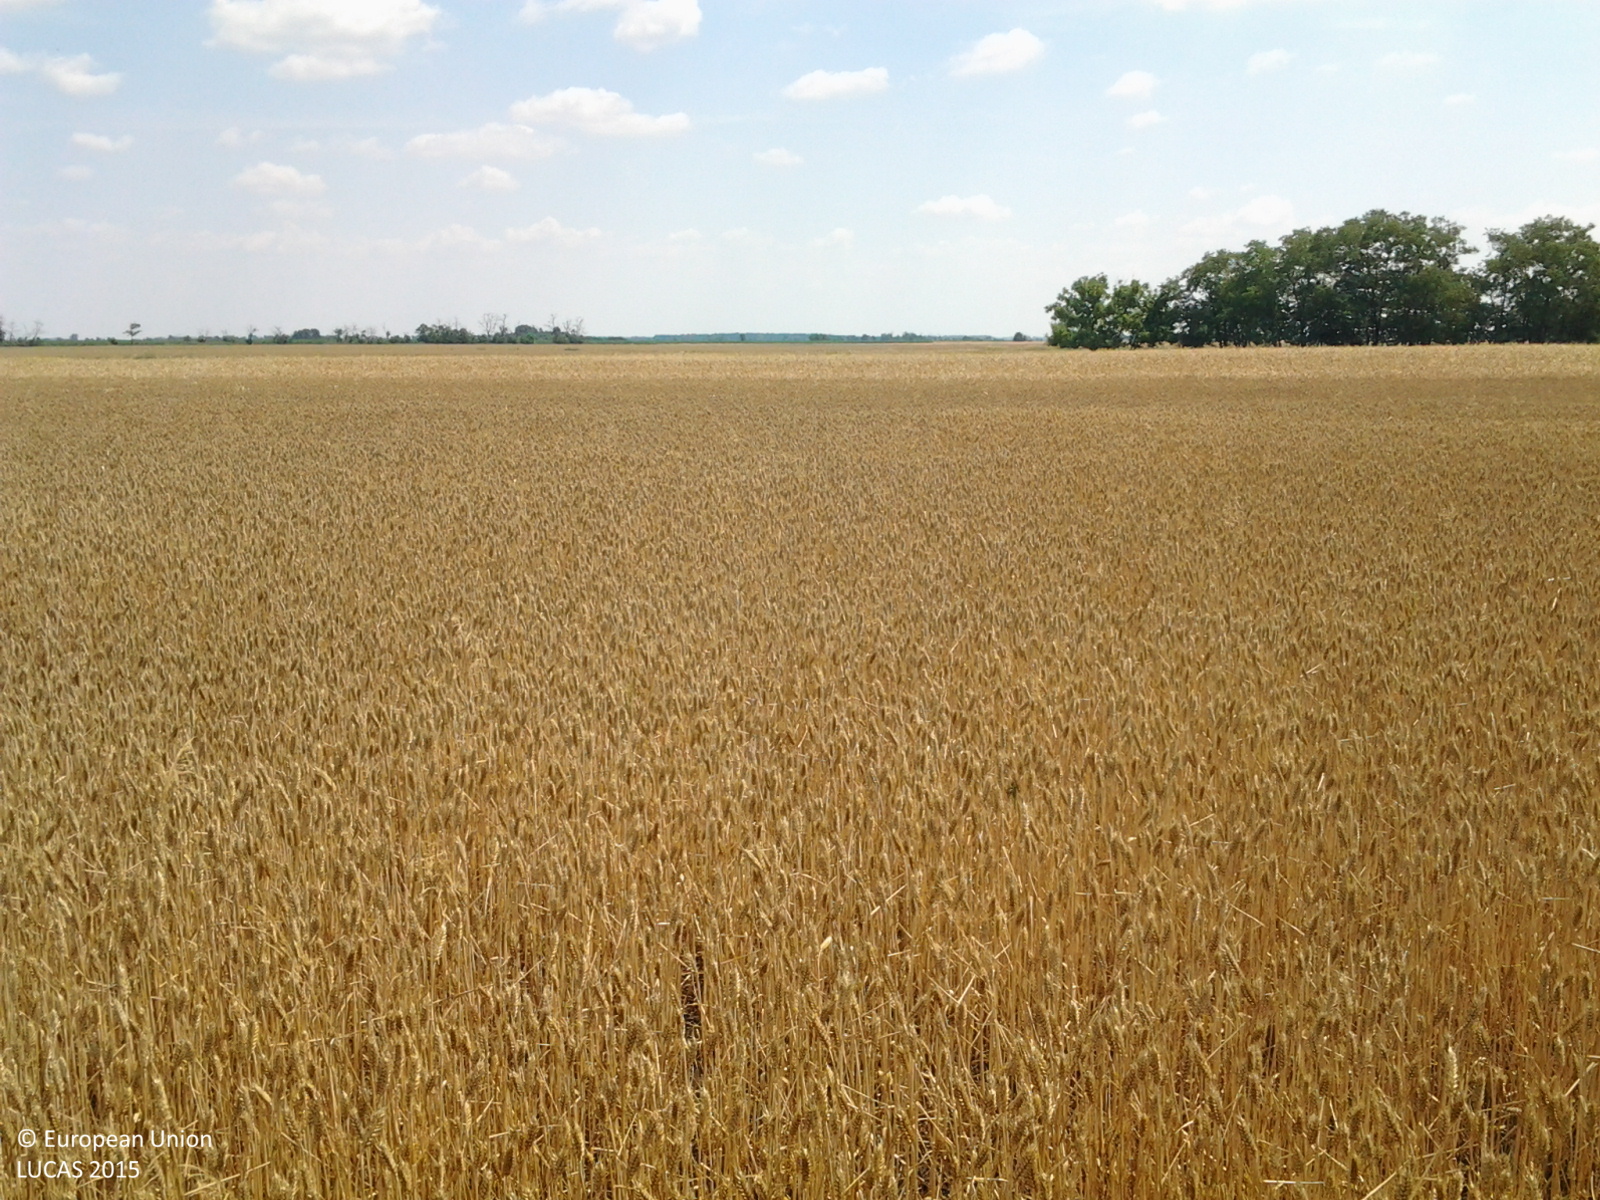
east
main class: Cropland
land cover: Common wheat
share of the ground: > 75 %
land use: Agriculture (excluding fallow land and kitchen gardens)
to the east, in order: Common wheat; Rye; Grassland with sparse tree/shrub cover; Common wheat
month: July
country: HU
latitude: 47.5950
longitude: 19.9067
